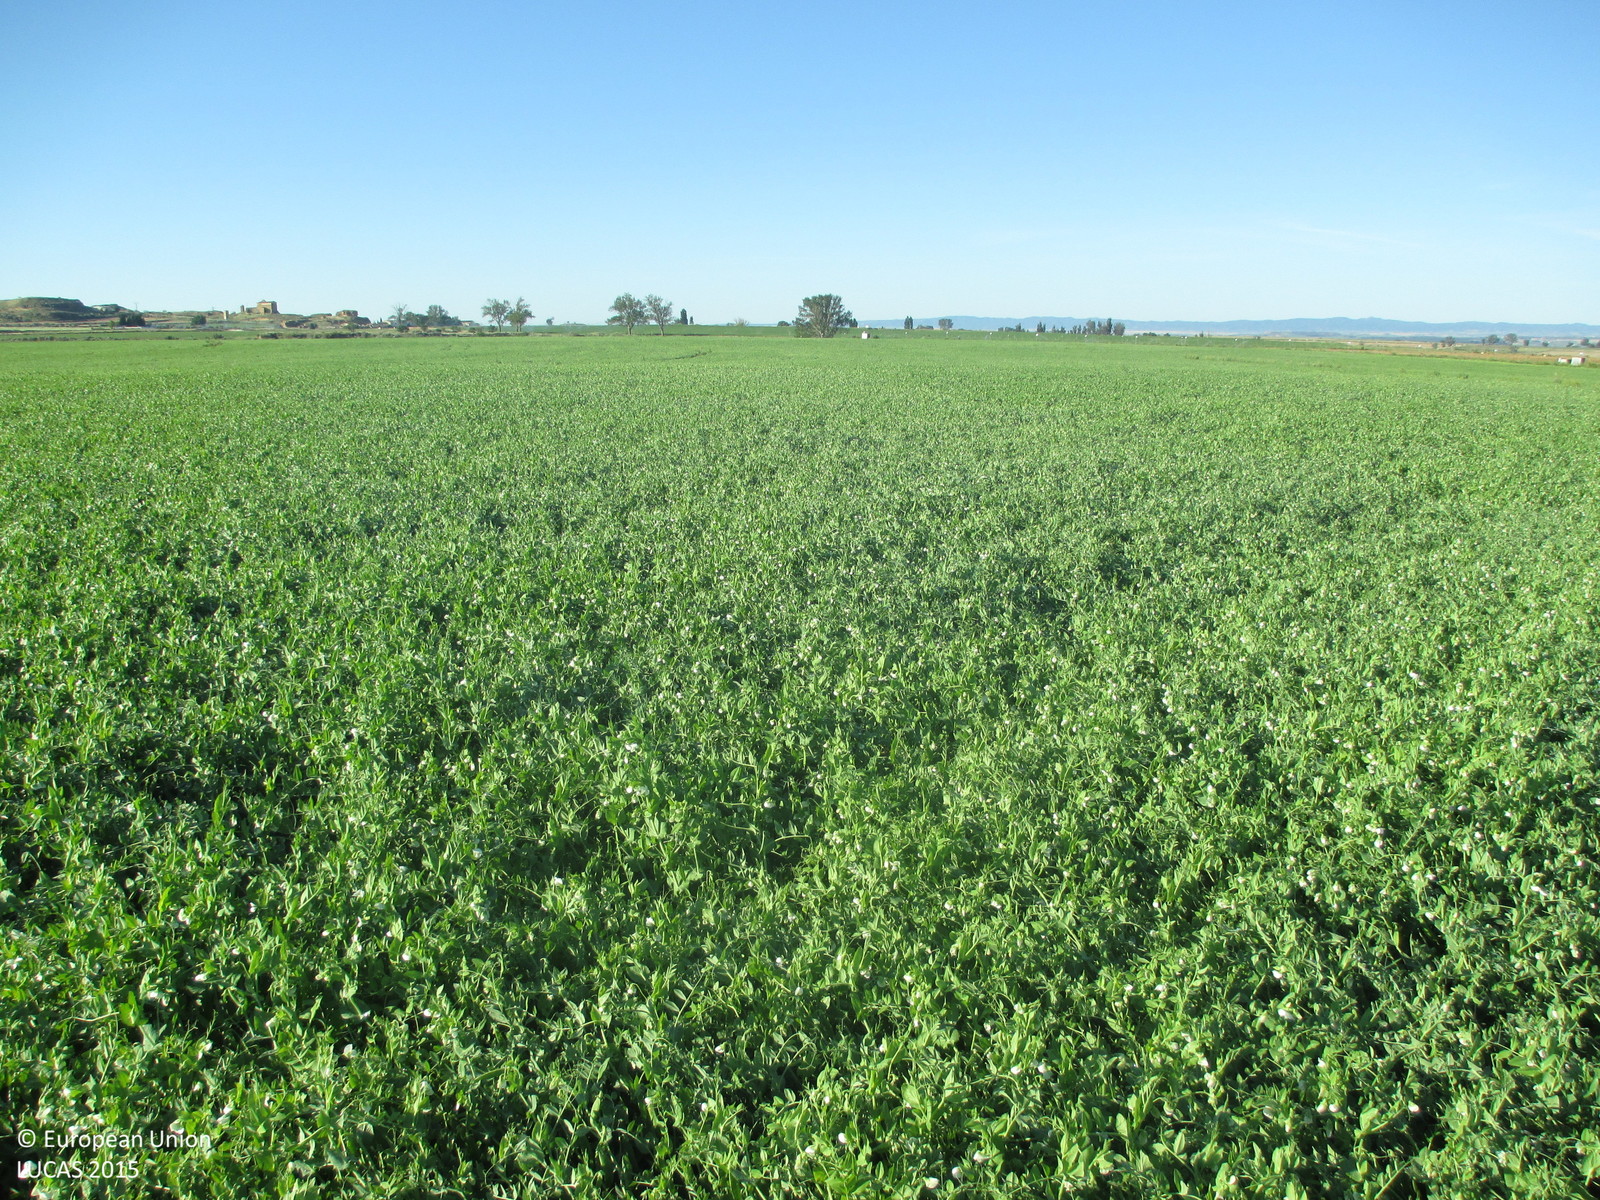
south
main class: Cropland
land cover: Dry pulses
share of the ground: > 75 %
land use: Agriculture (excluding fallow land and kitchen gardens)
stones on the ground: < 10 %
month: May
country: ES
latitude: 41.9471
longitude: -0.2856
